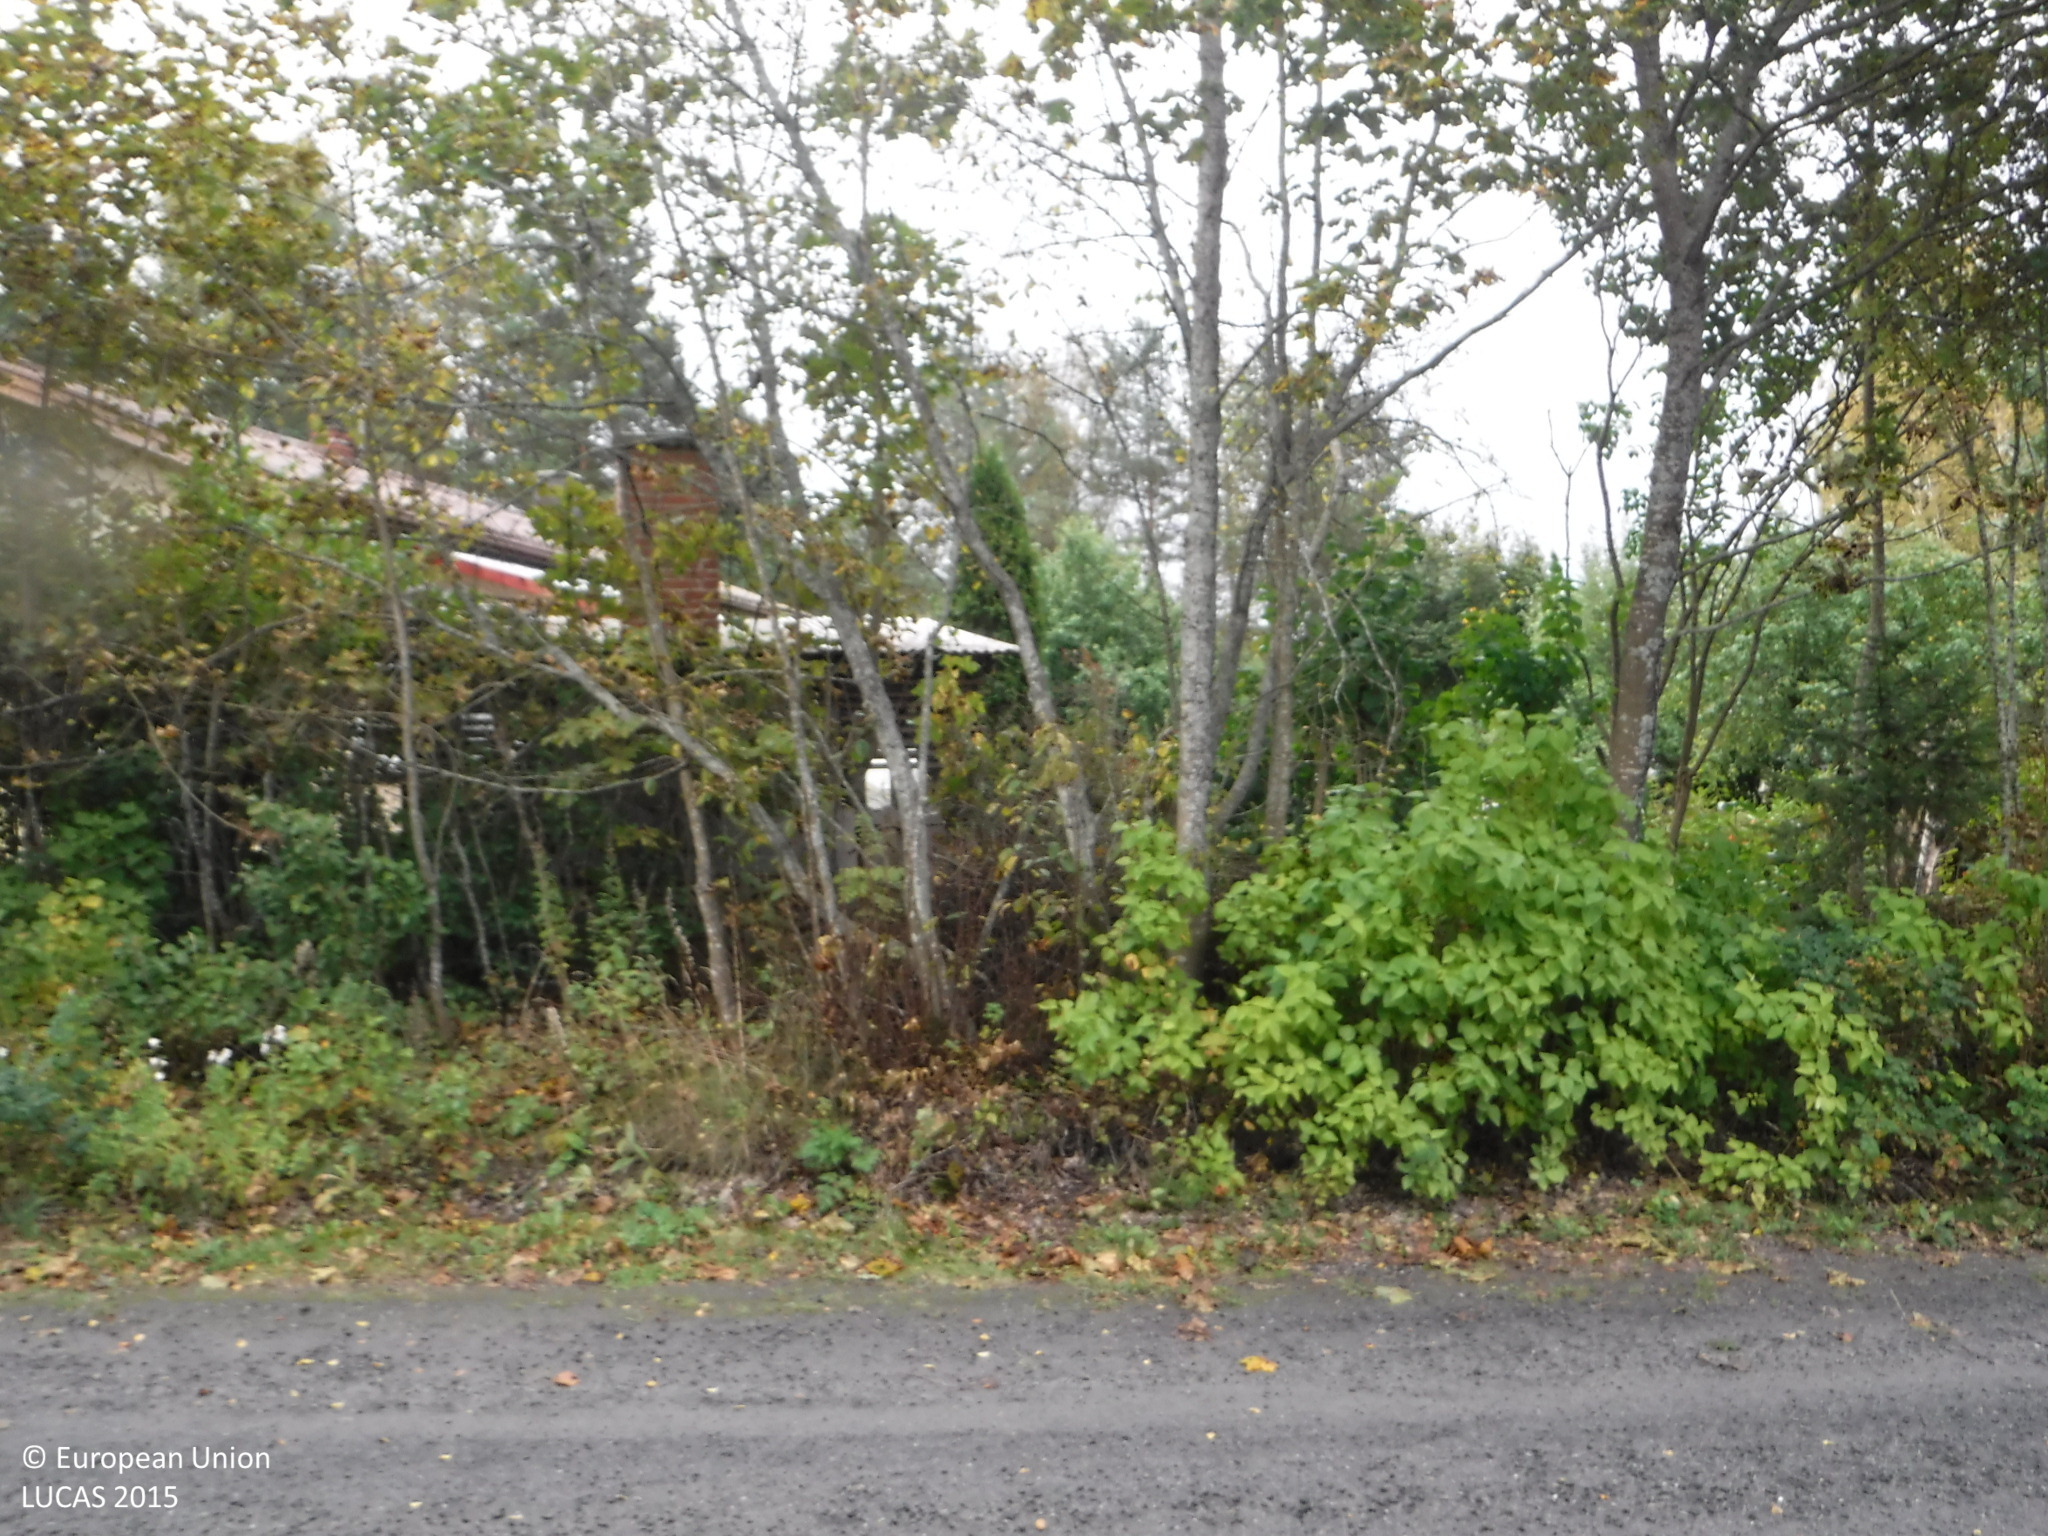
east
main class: Woodland
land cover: Broadleaved woodland
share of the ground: > 75 %
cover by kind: broadleaved forest trees 80 %, herbaceous plants 20 %
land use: Semi-natural and natural areas not in use
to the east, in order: Spontaneously vegetated surfaces; Broadleaved woodland; Artificial constructions in urban areas
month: September
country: FI
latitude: 61.4871
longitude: 24.0805
